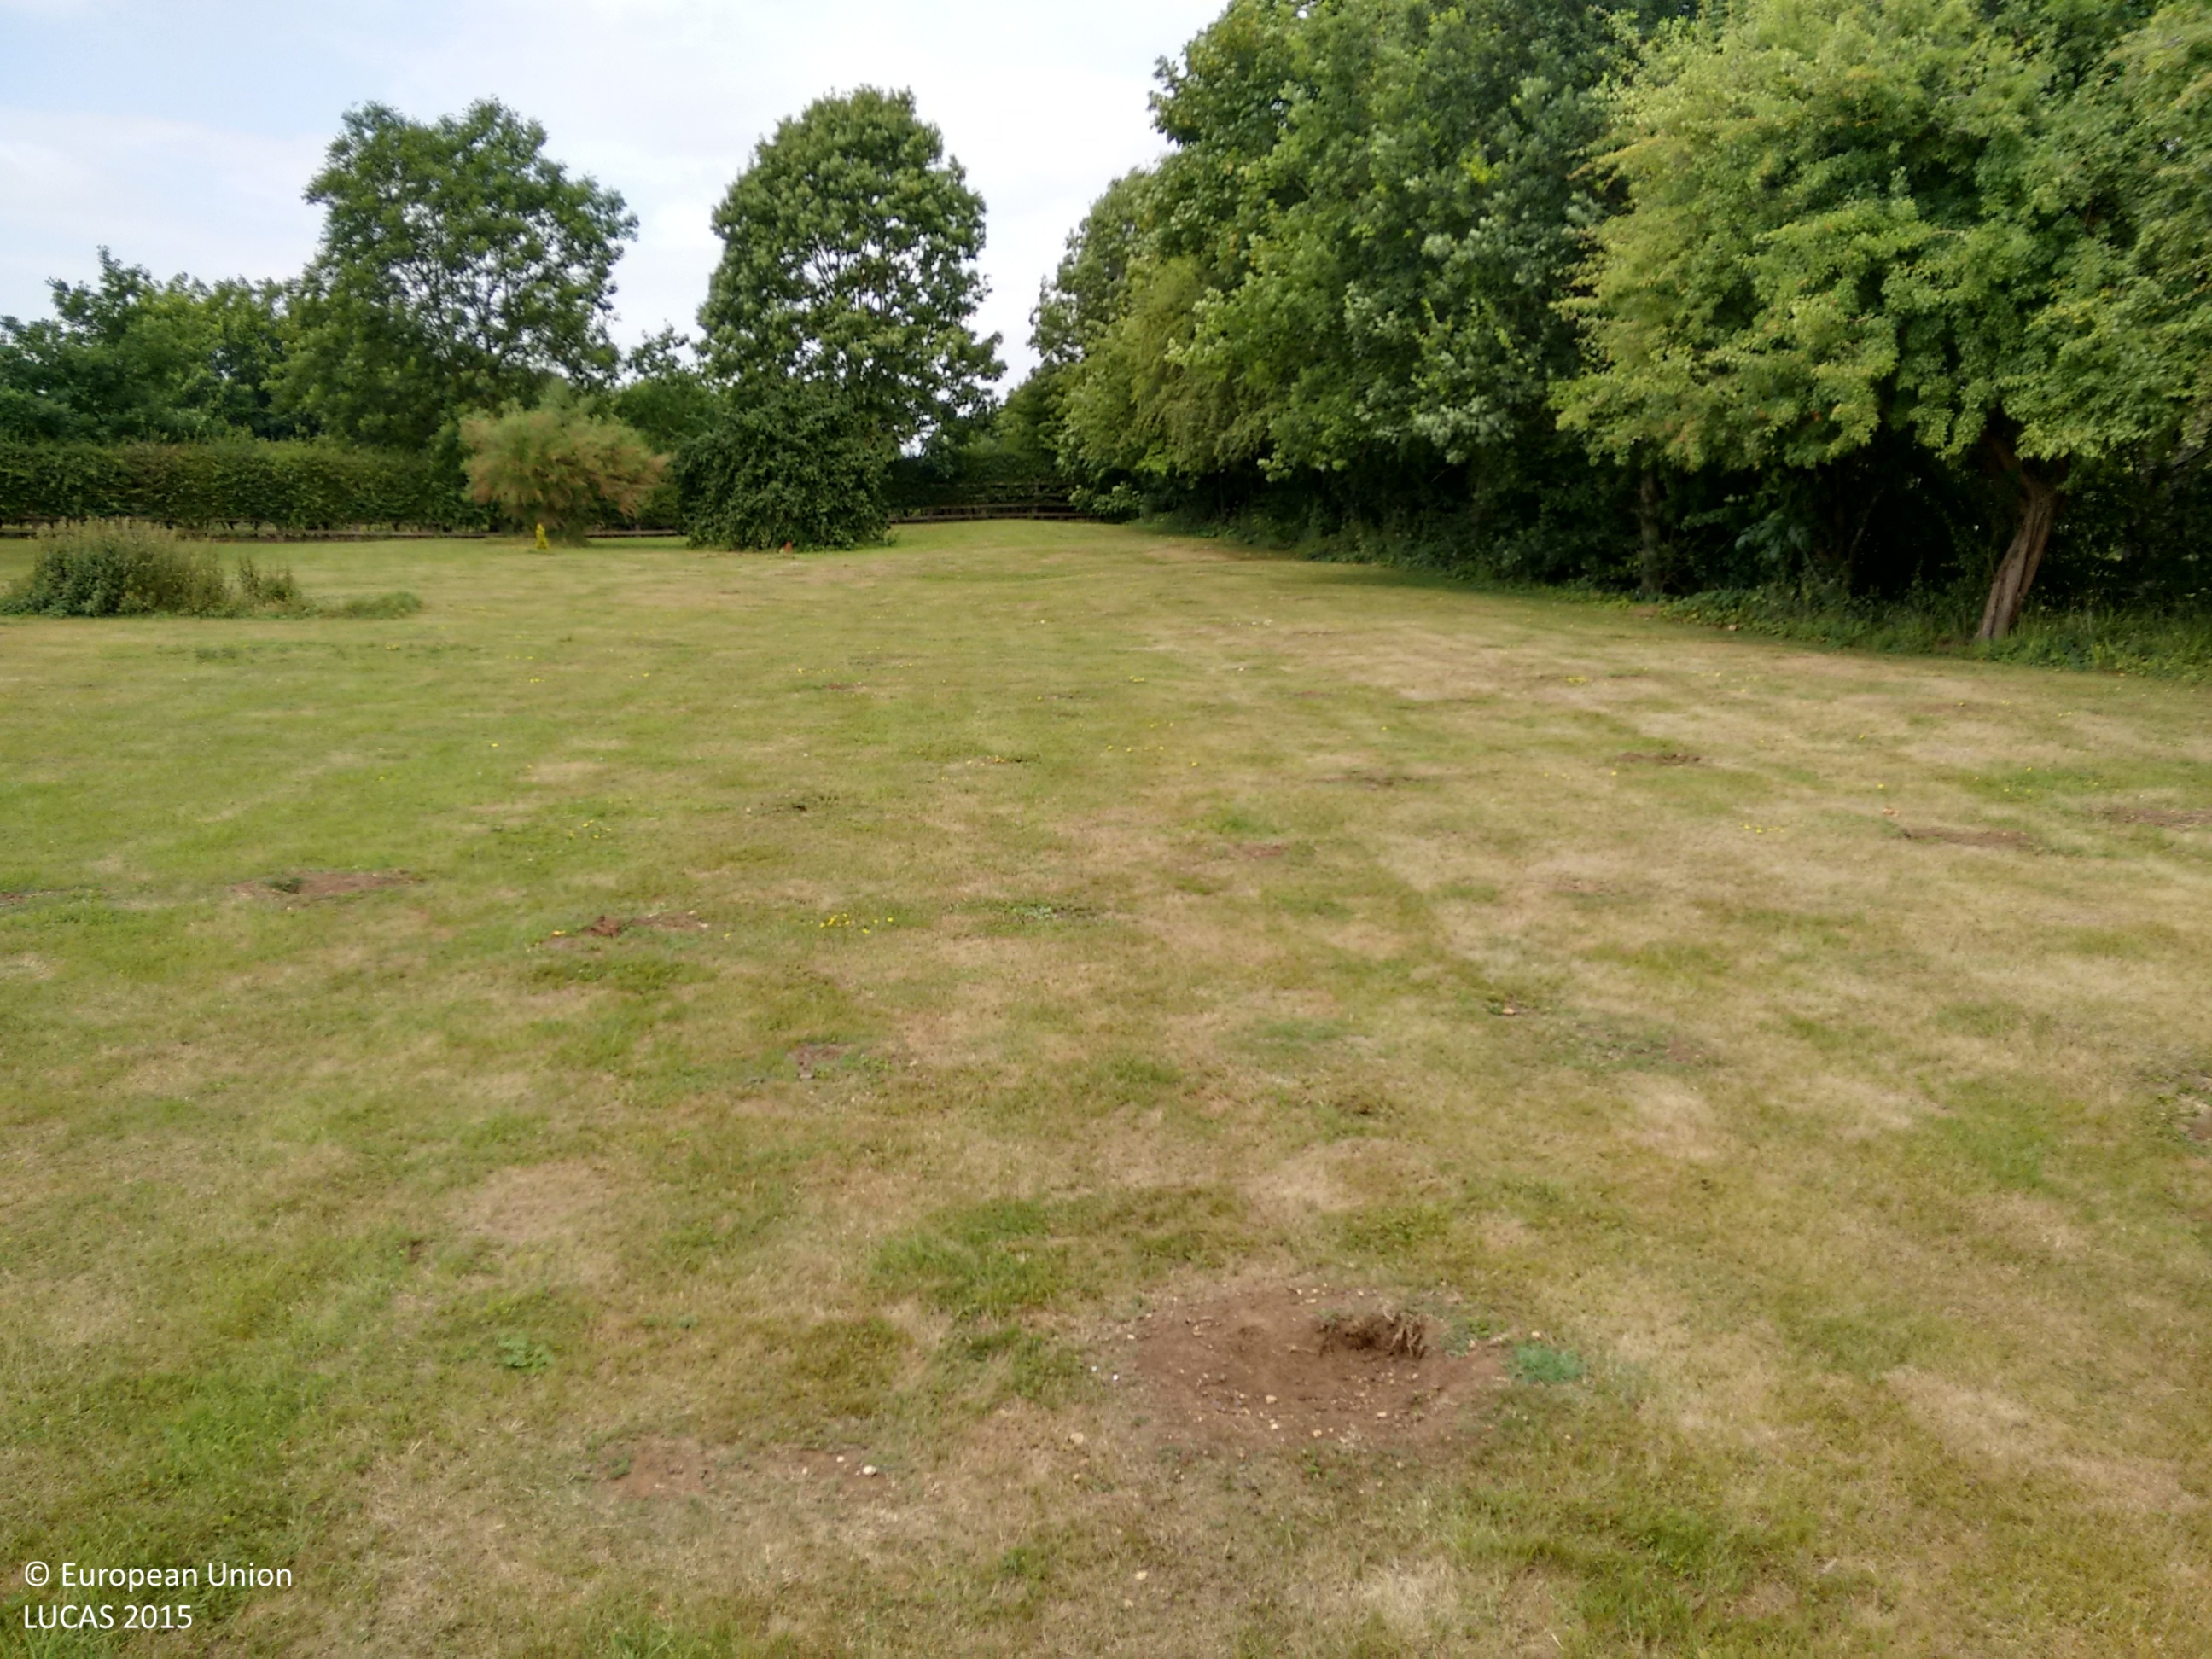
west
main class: Grassland
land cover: Grassland without tree/shrub cover
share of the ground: > 75 %
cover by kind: herbaceous plants 100 %
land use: Residential
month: July
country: GB
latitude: 52.4335
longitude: -0.7340
